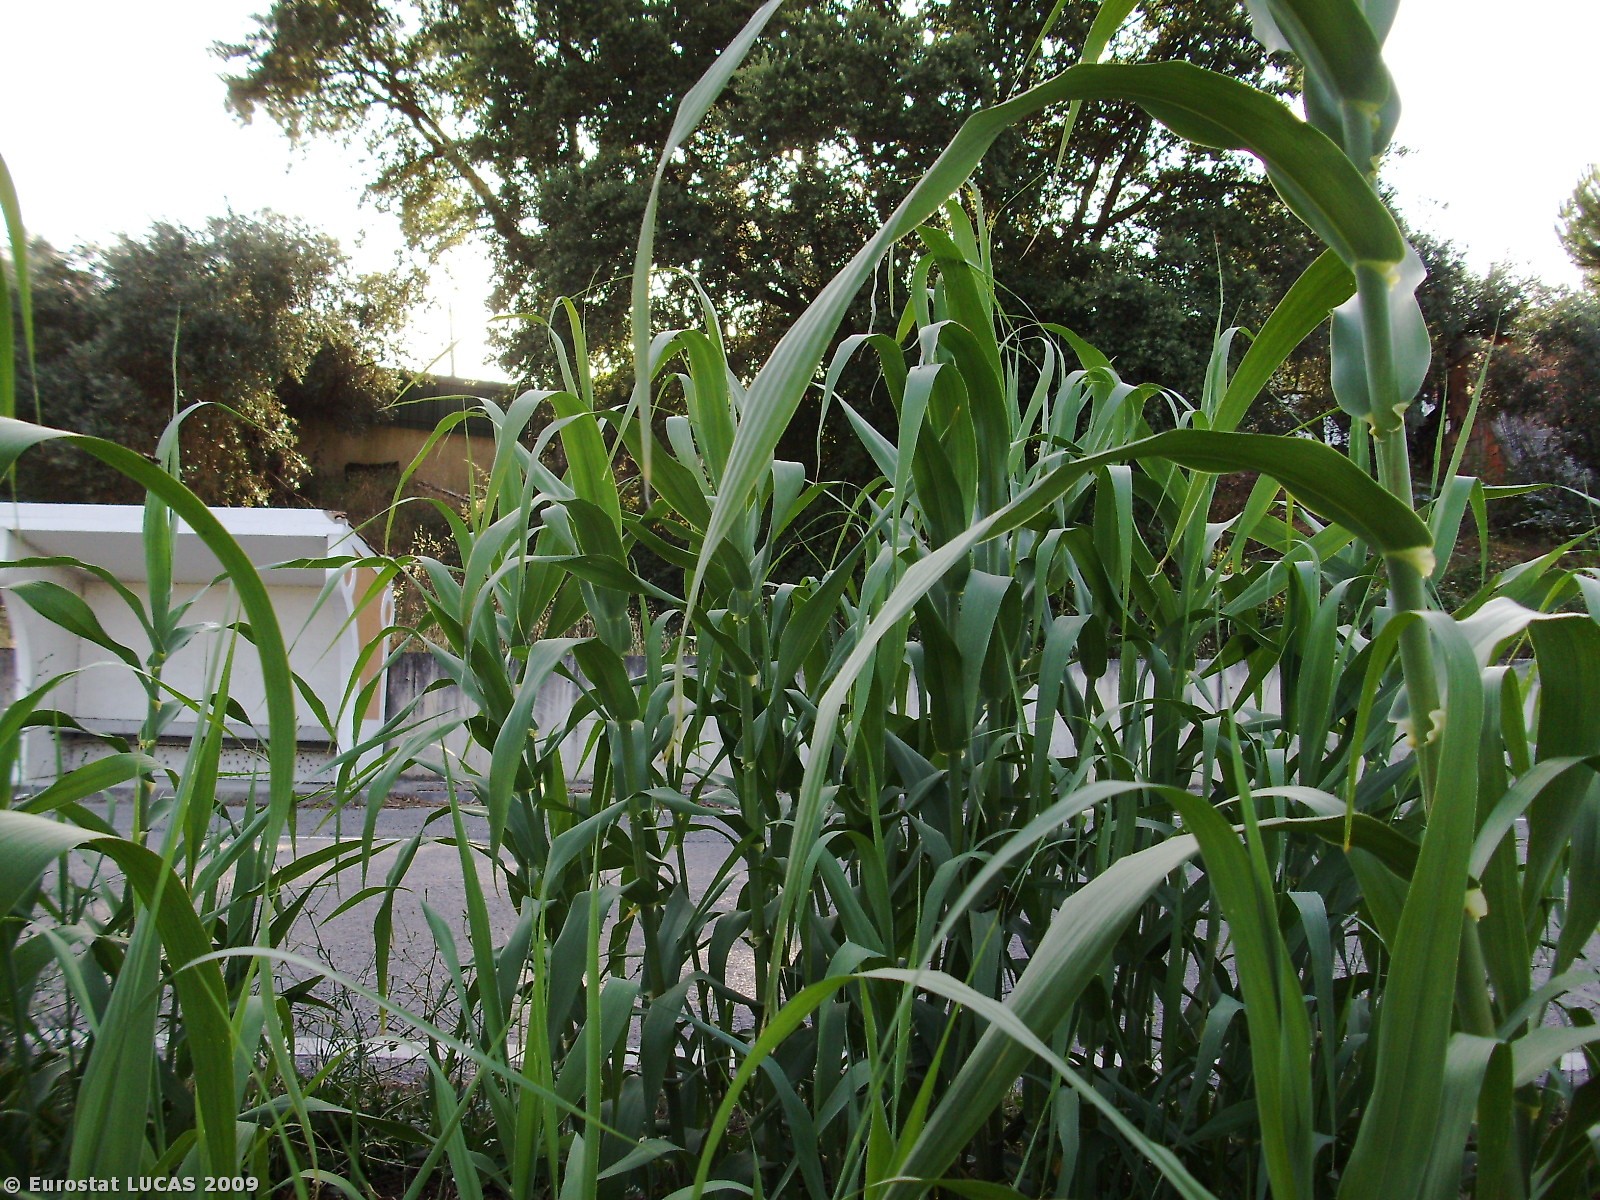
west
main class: Grassland
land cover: Spontaneously vegetated surfaces
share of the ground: > 75 %
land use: Fallow land
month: July
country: PT
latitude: 39.3573
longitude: -8.8930
